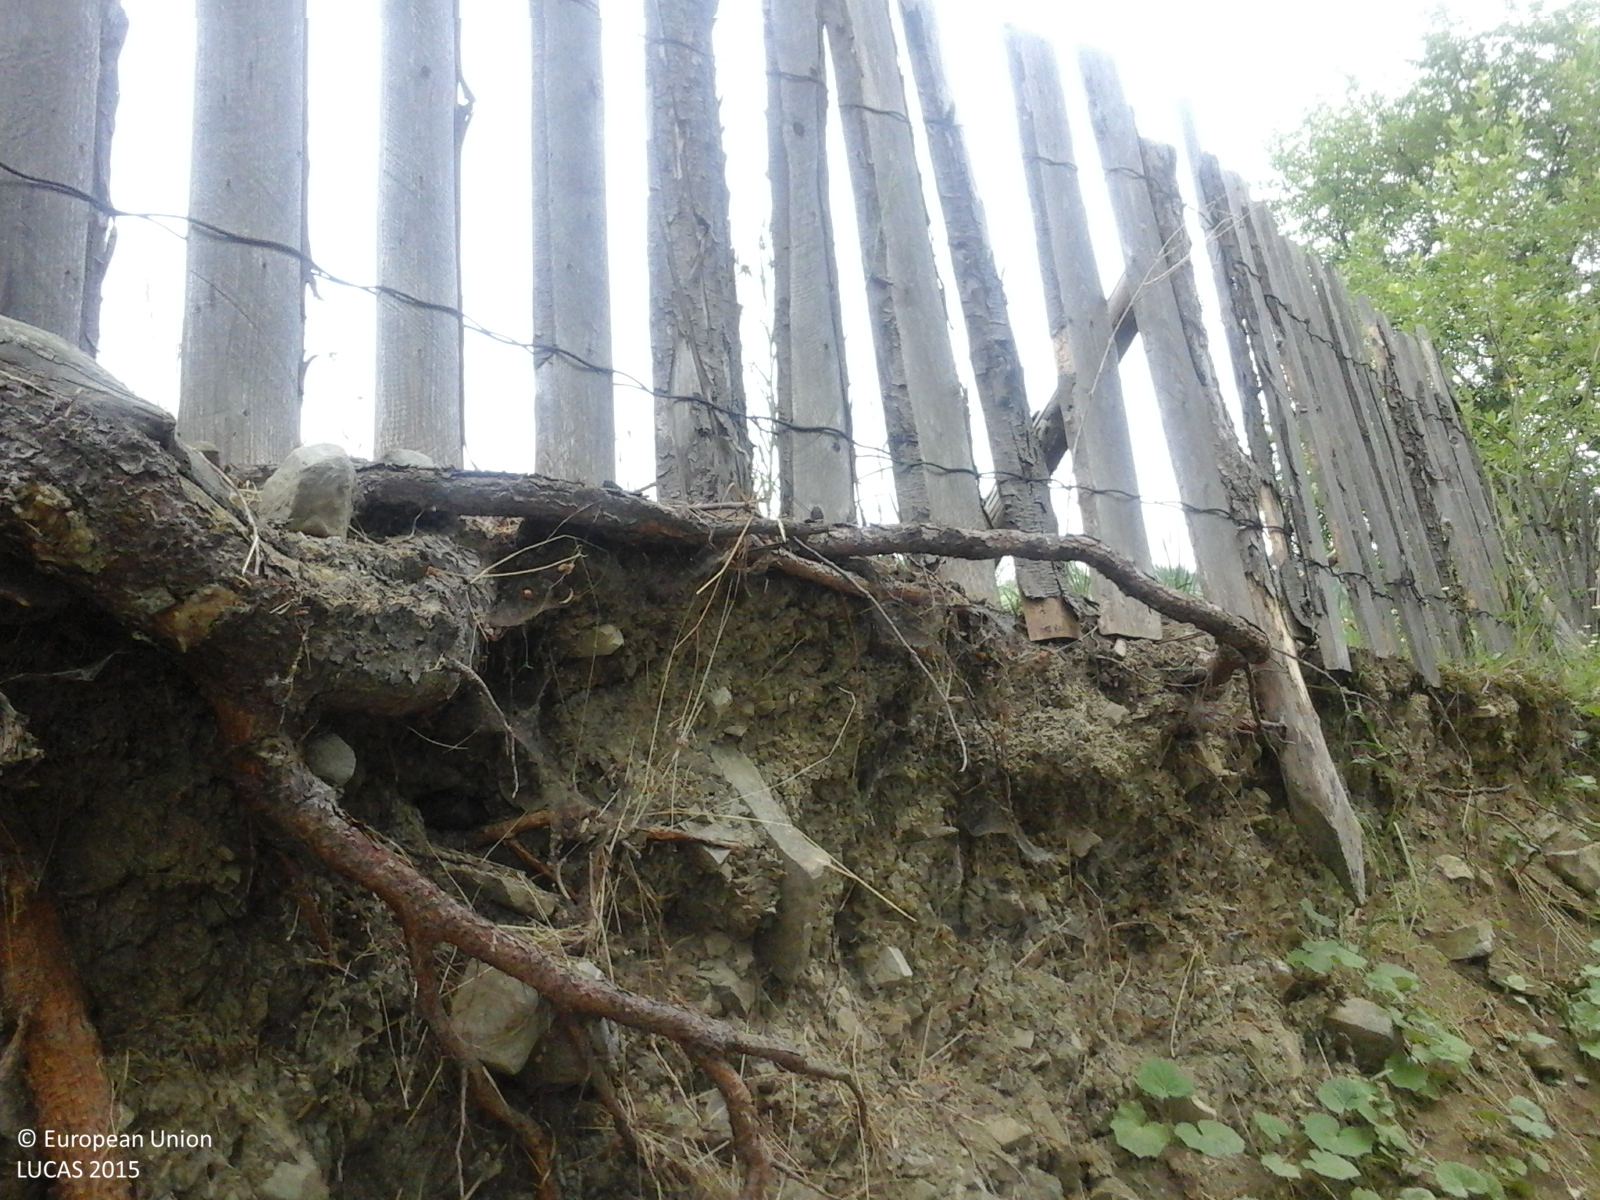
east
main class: Grassland
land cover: Grassland without tree/shrub cover
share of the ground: > 75 %
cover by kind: herbaceous plants 100 %
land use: Agriculture (excluding fallow land and kitchen gardens)
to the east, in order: Grassland without tree/shrub cover; Grassland with sparse tree/shrub cover; Rivers and streams; Grassland with sparse tree/shrub cover; Grassland without tree/shrub cover; Artificial constructions in urban areas; Grassland without tree/shrub cover; Abandoned hedges; Grassland without tree/shrub cover; Fences; Grassland without tree/shrub cover; Single bushes/trees; Grassland without tree/shrub cover; Fences; Grassland without tree/shrub cover
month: June
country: RO
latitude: 47.4963
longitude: 25.8004
